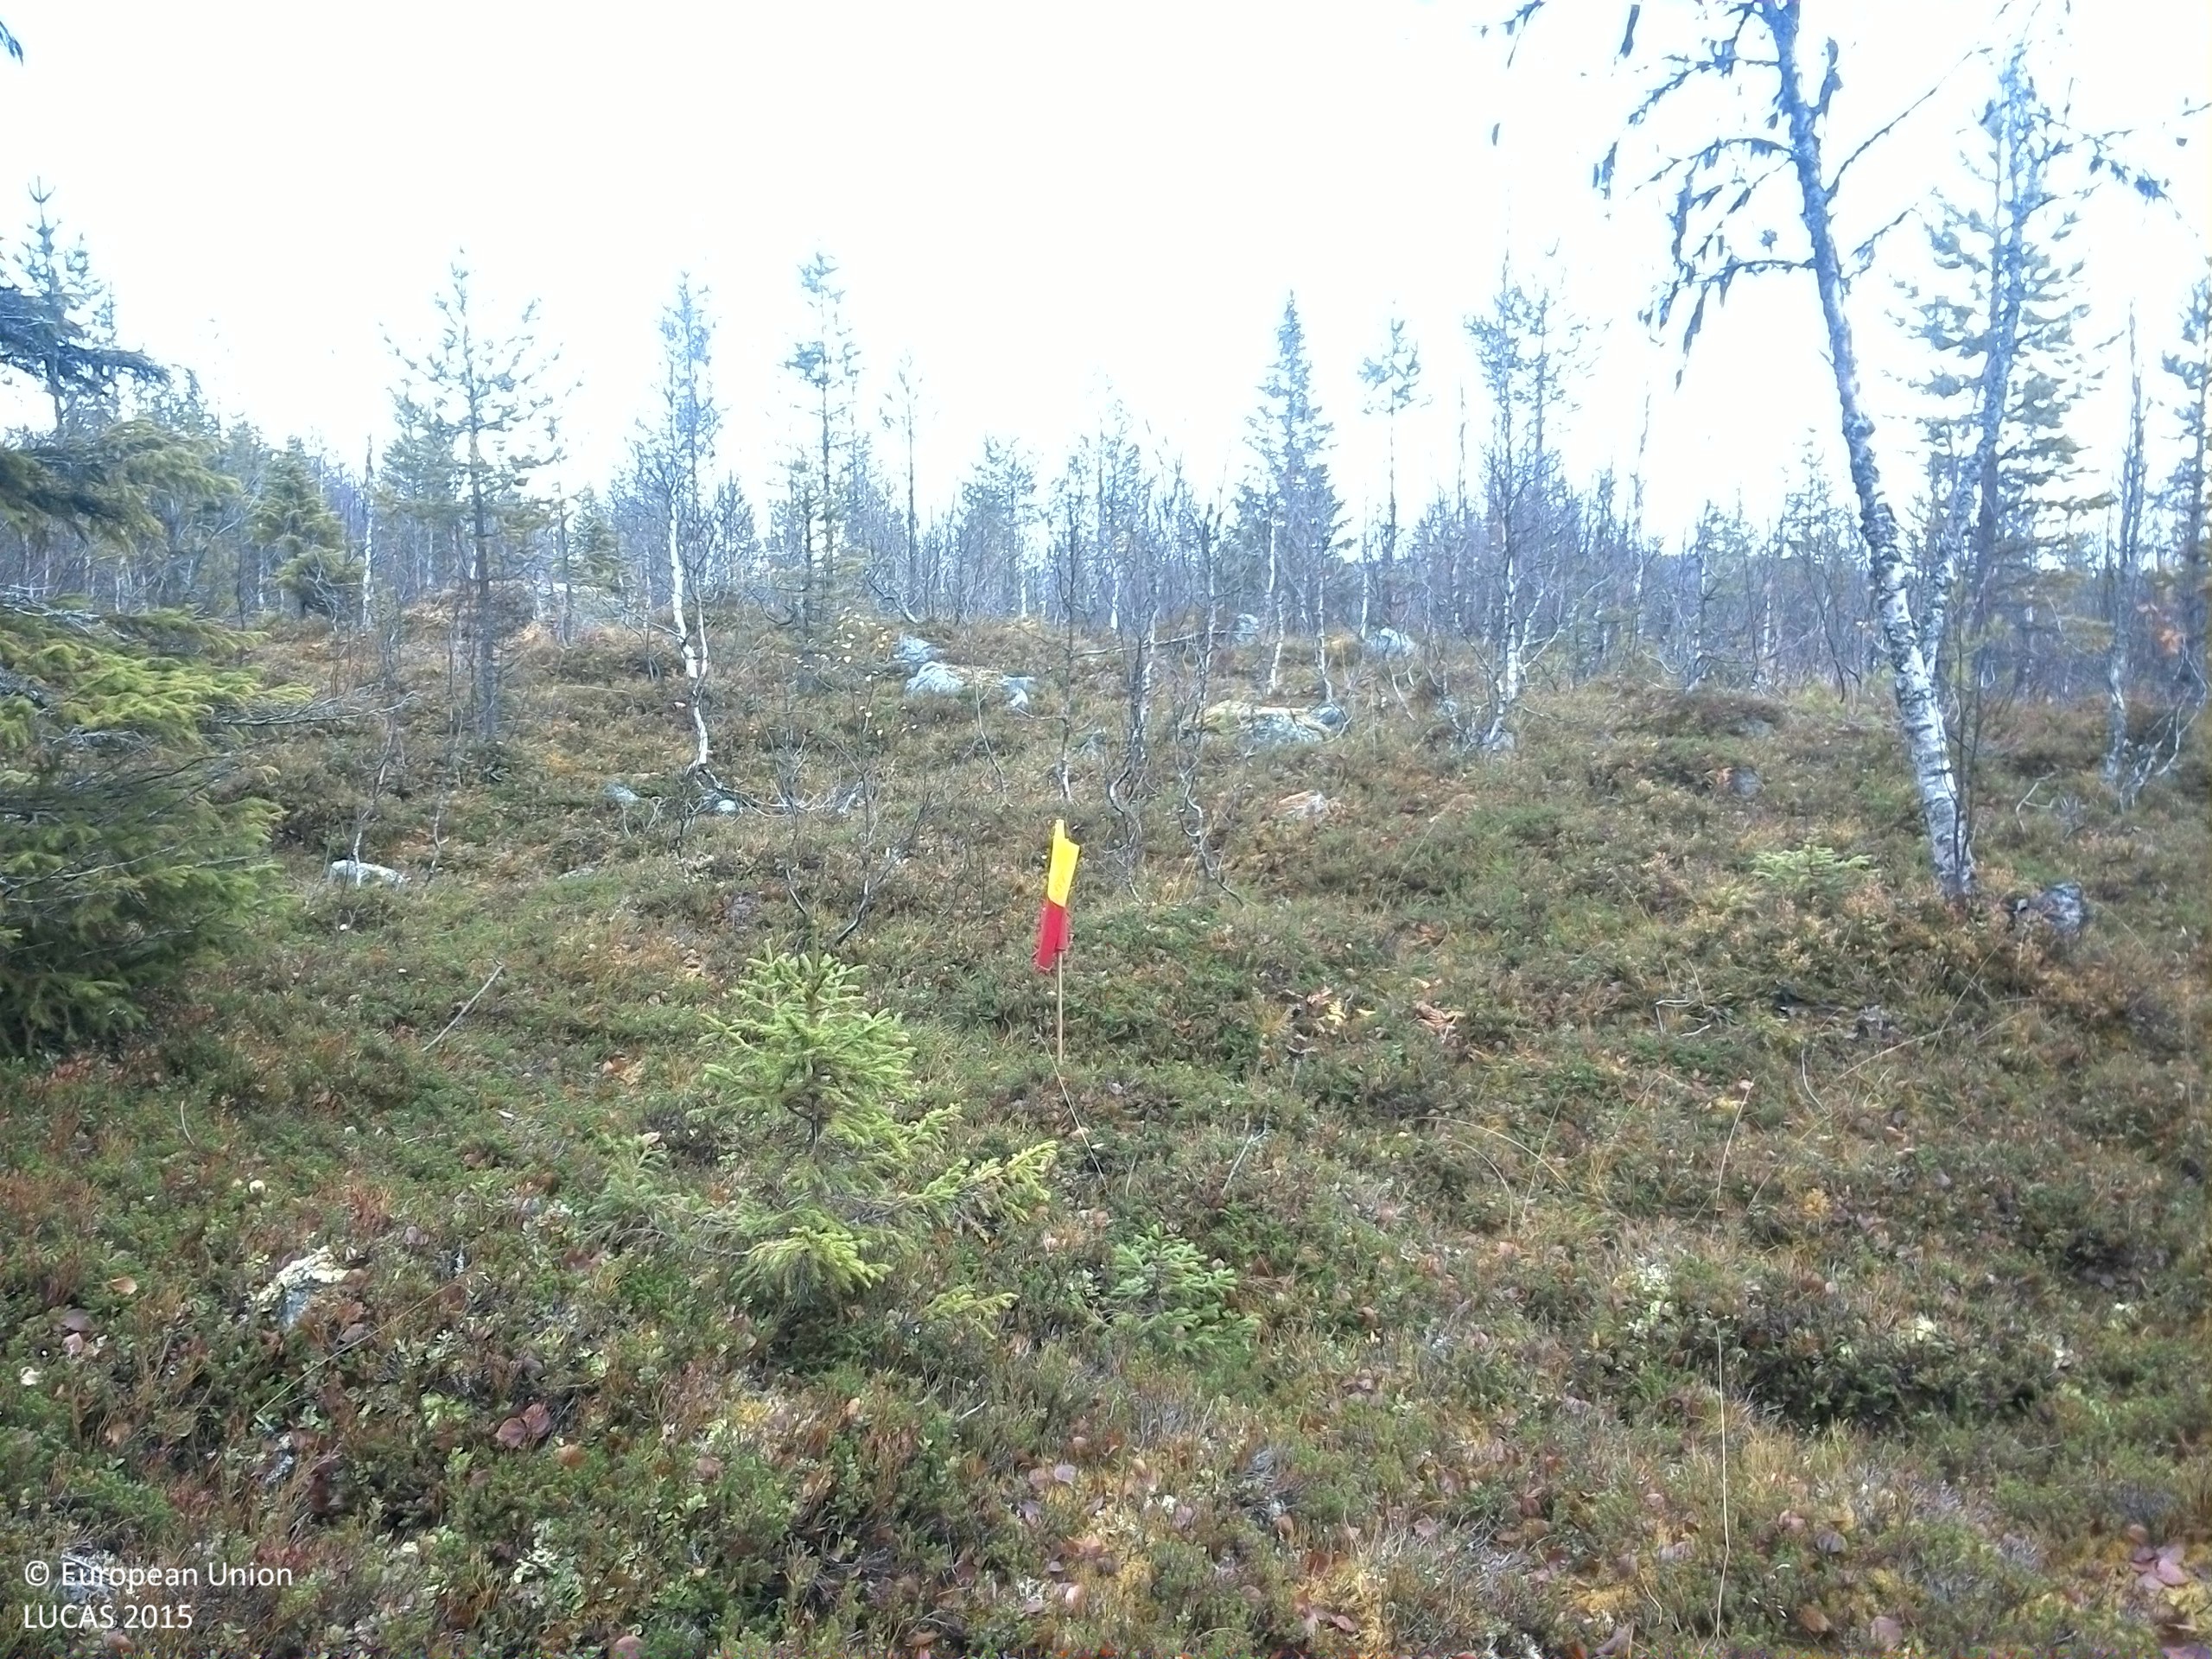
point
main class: Woodland
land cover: Pine dominated mixed woodland
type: boreal forest
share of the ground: 25 - 50 %
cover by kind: broadleaved forest trees 30 %, shrubs 30 %, coniferous forest trees 15 %, lichens and mosses 15 %, consolidated bare surface 10 %
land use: Forestry
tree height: < 5 m
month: October
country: SE
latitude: 64.4337
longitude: 14.8117
